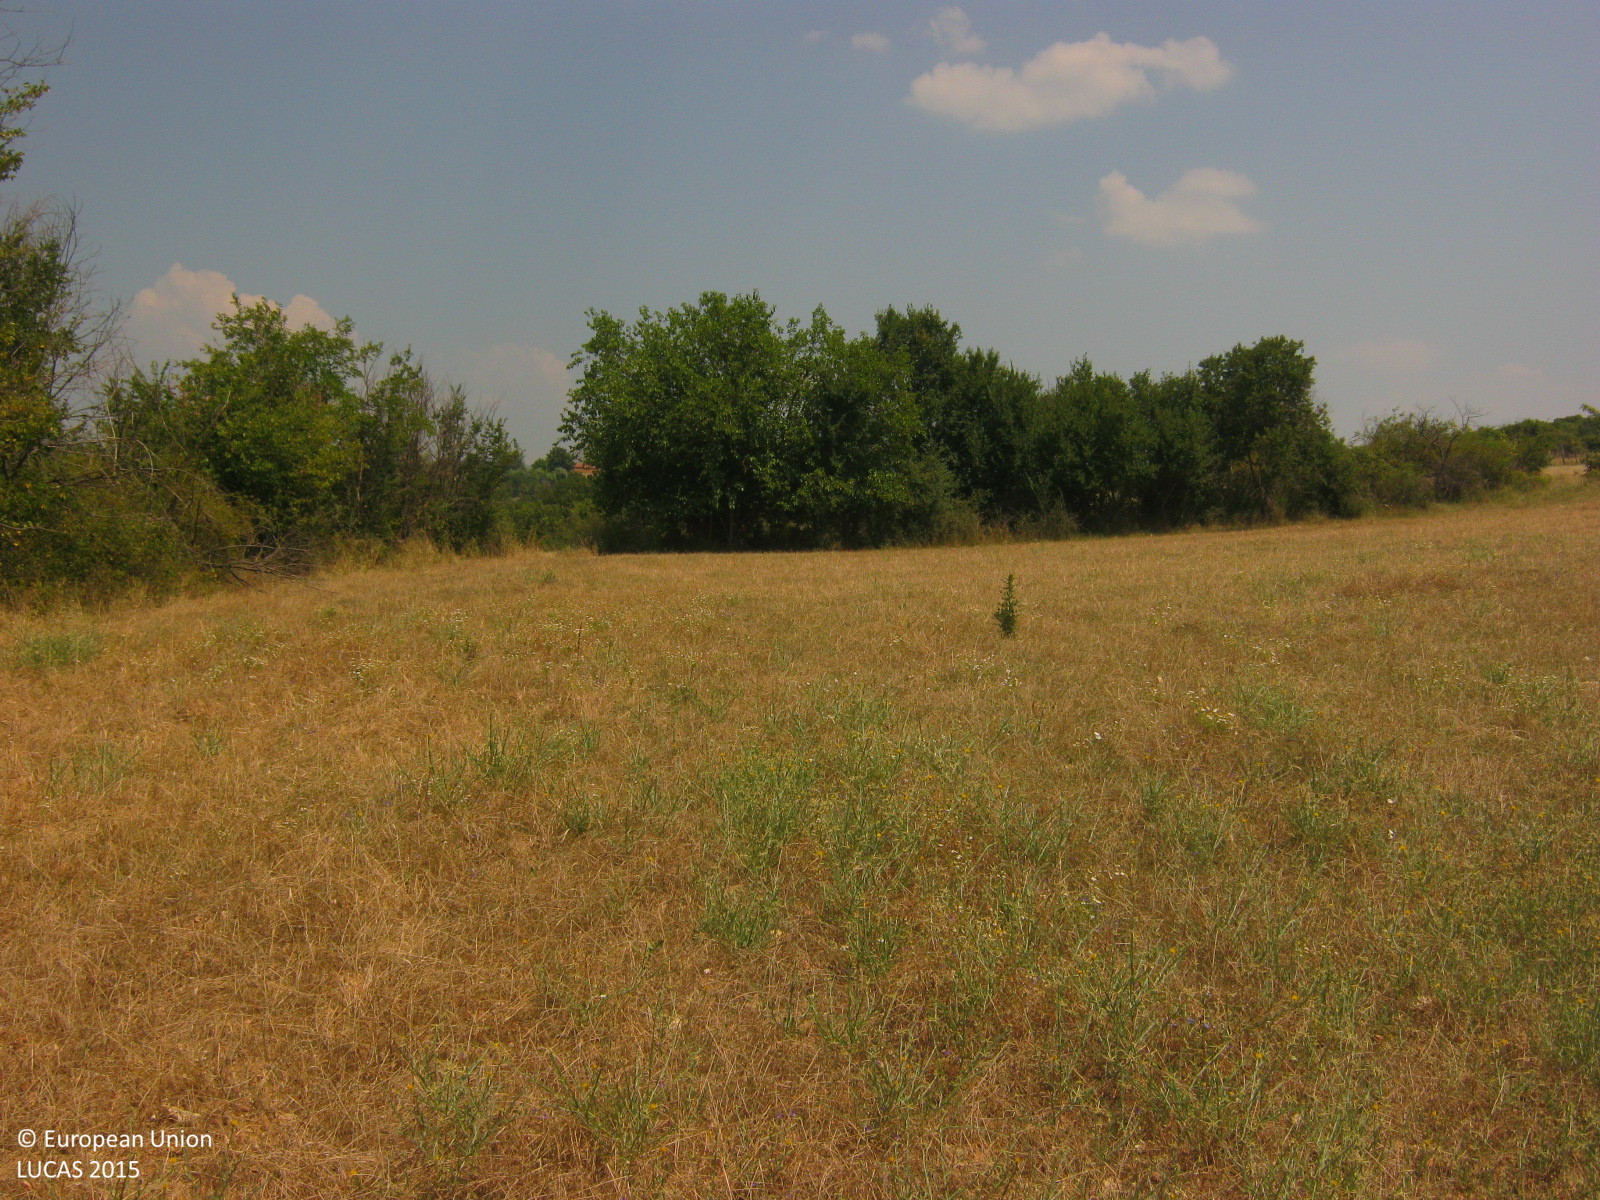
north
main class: Grassland
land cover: Spontaneously vegetated surfaces
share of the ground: > 75 %
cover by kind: herbaceous plants 95 %, unconsolidated bare surface 5 %
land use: Fallow land
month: July
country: GR
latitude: 41.1829
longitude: 24.3750
